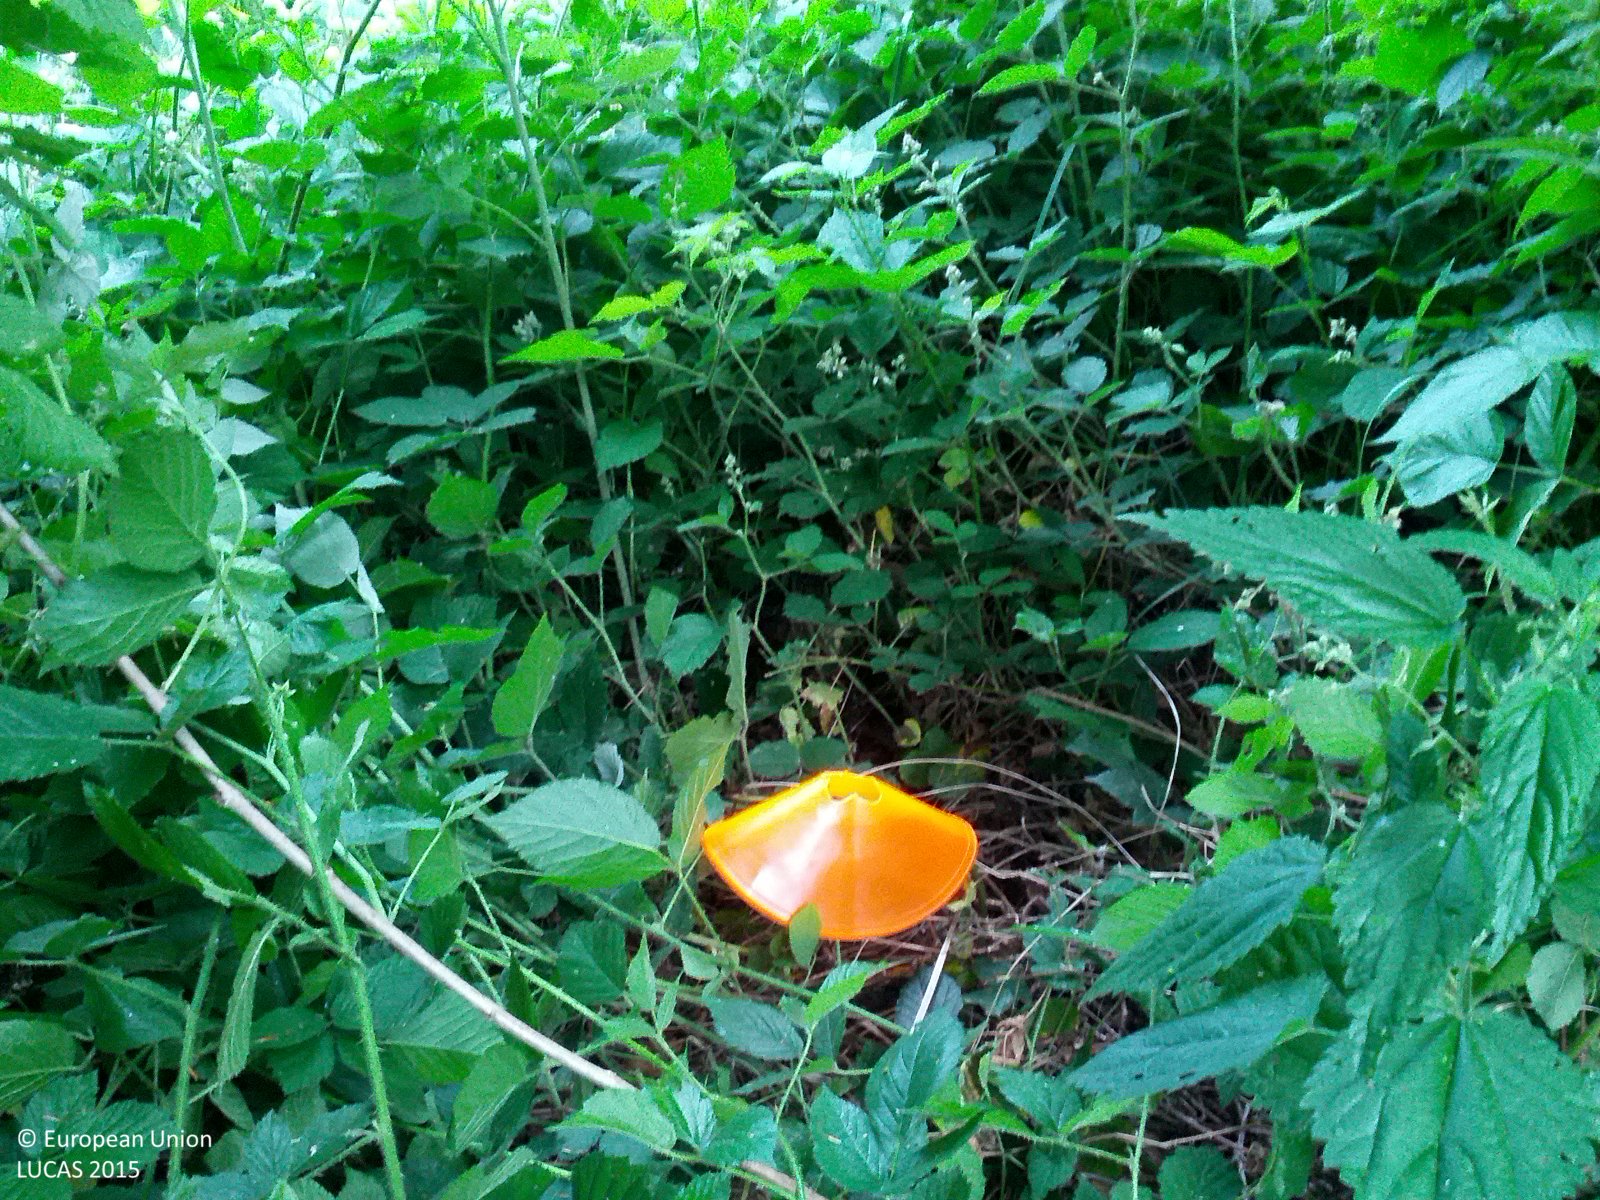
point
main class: Shrubland
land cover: Shrubland with sparse tree cover
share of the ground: > 75 %
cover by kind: shrubs 75 %, herbaceous plants 20 %, broadleaved forest trees 5 %
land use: Forestry
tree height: > 5 m
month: June
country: AT
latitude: 48.1482
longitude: 16.0388
